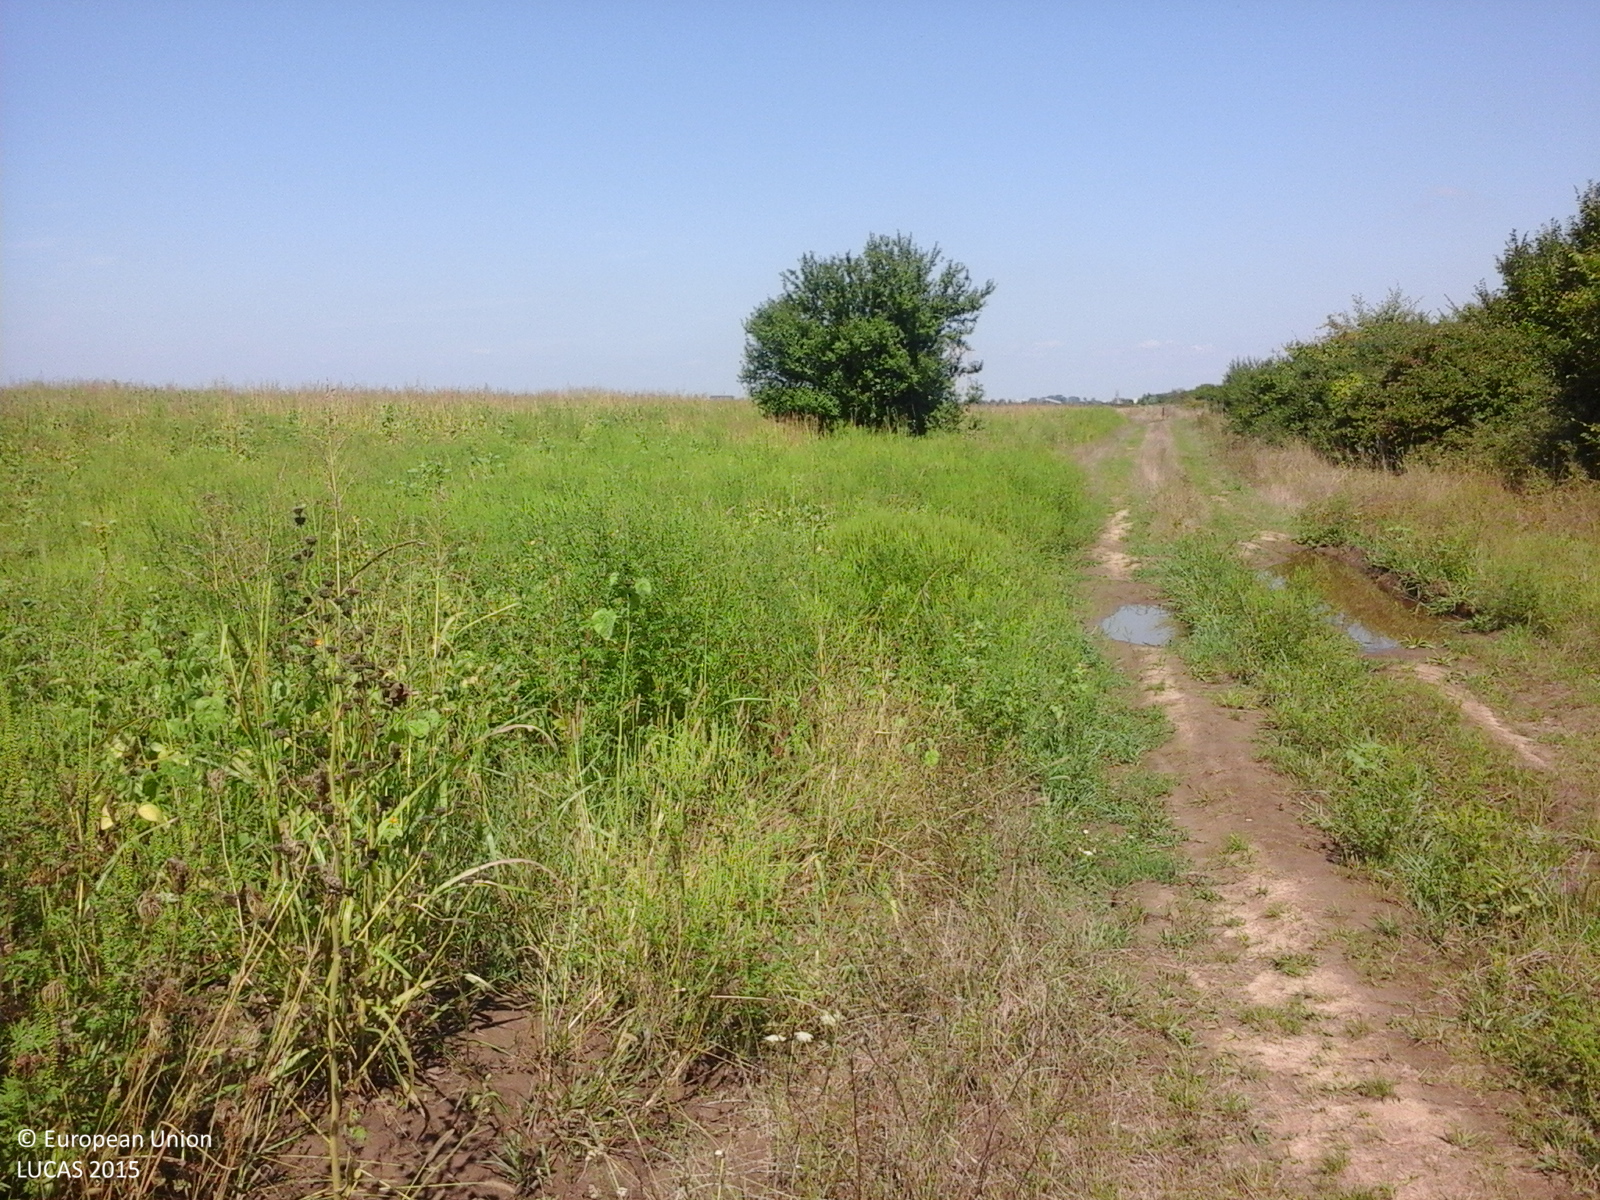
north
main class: Cropland
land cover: Soya
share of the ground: > 75 %
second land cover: Spontaneously vegetated surfaces
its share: > 75 %
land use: Agriculture (excluding fallow land and kitchen gardens)
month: August
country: RO
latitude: 45.6718
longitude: 21.1847
